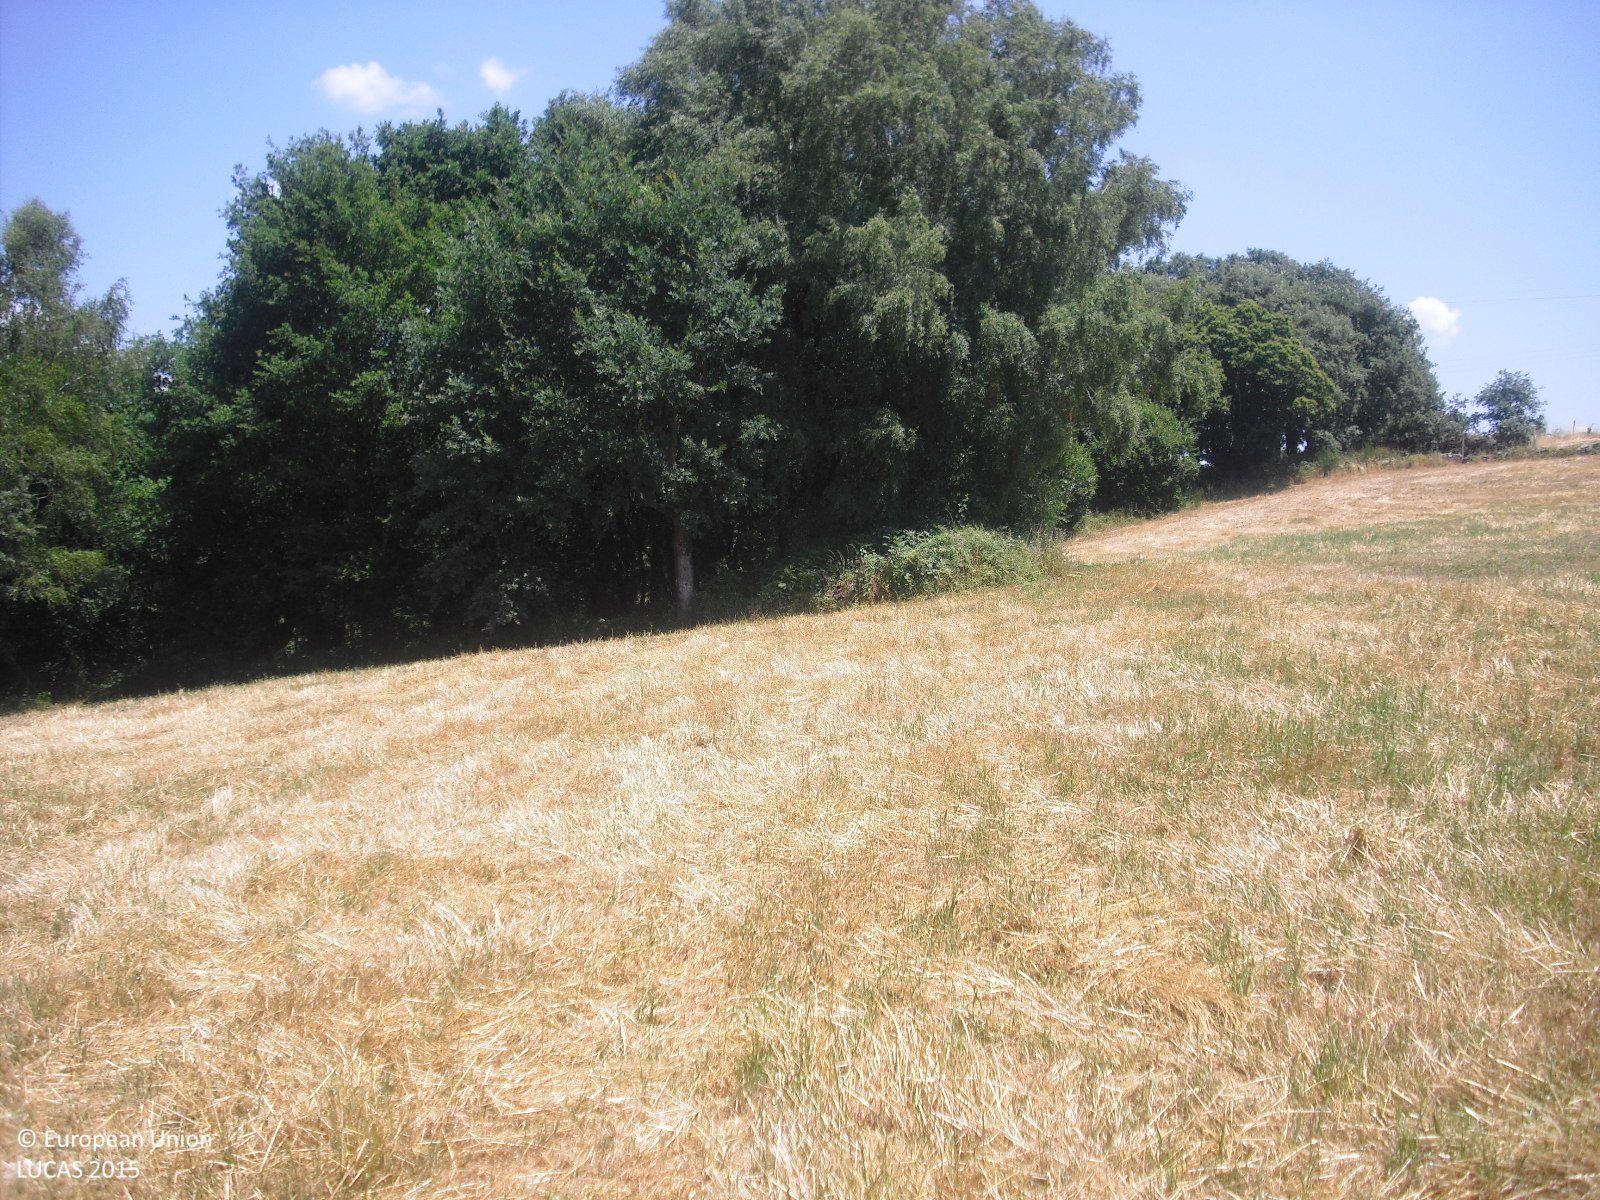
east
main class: Cropland
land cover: Temporary grasslands
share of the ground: > 75 %
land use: Agriculture (excluding fallow land and kitchen gardens)
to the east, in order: Temporary grasslands; Shruby margins; Dry stone walls; Broadleaved woodland; Shruby margins; Grassland without tree/shrub cover; Nuts trees; Dry stone walls; Tracks; Dry stone walls; Broadleaved woodland; Shrubland without tree cover; Dry stone walls; Shrubland without tree cover; Electric lines; Grassland with sparse tree/shrub cover; Grassland without tree/shrub cover; Grassland with sparse tree/shrub cover; Nuts trees
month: June
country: ES
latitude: 42.6743
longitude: -7.7600
